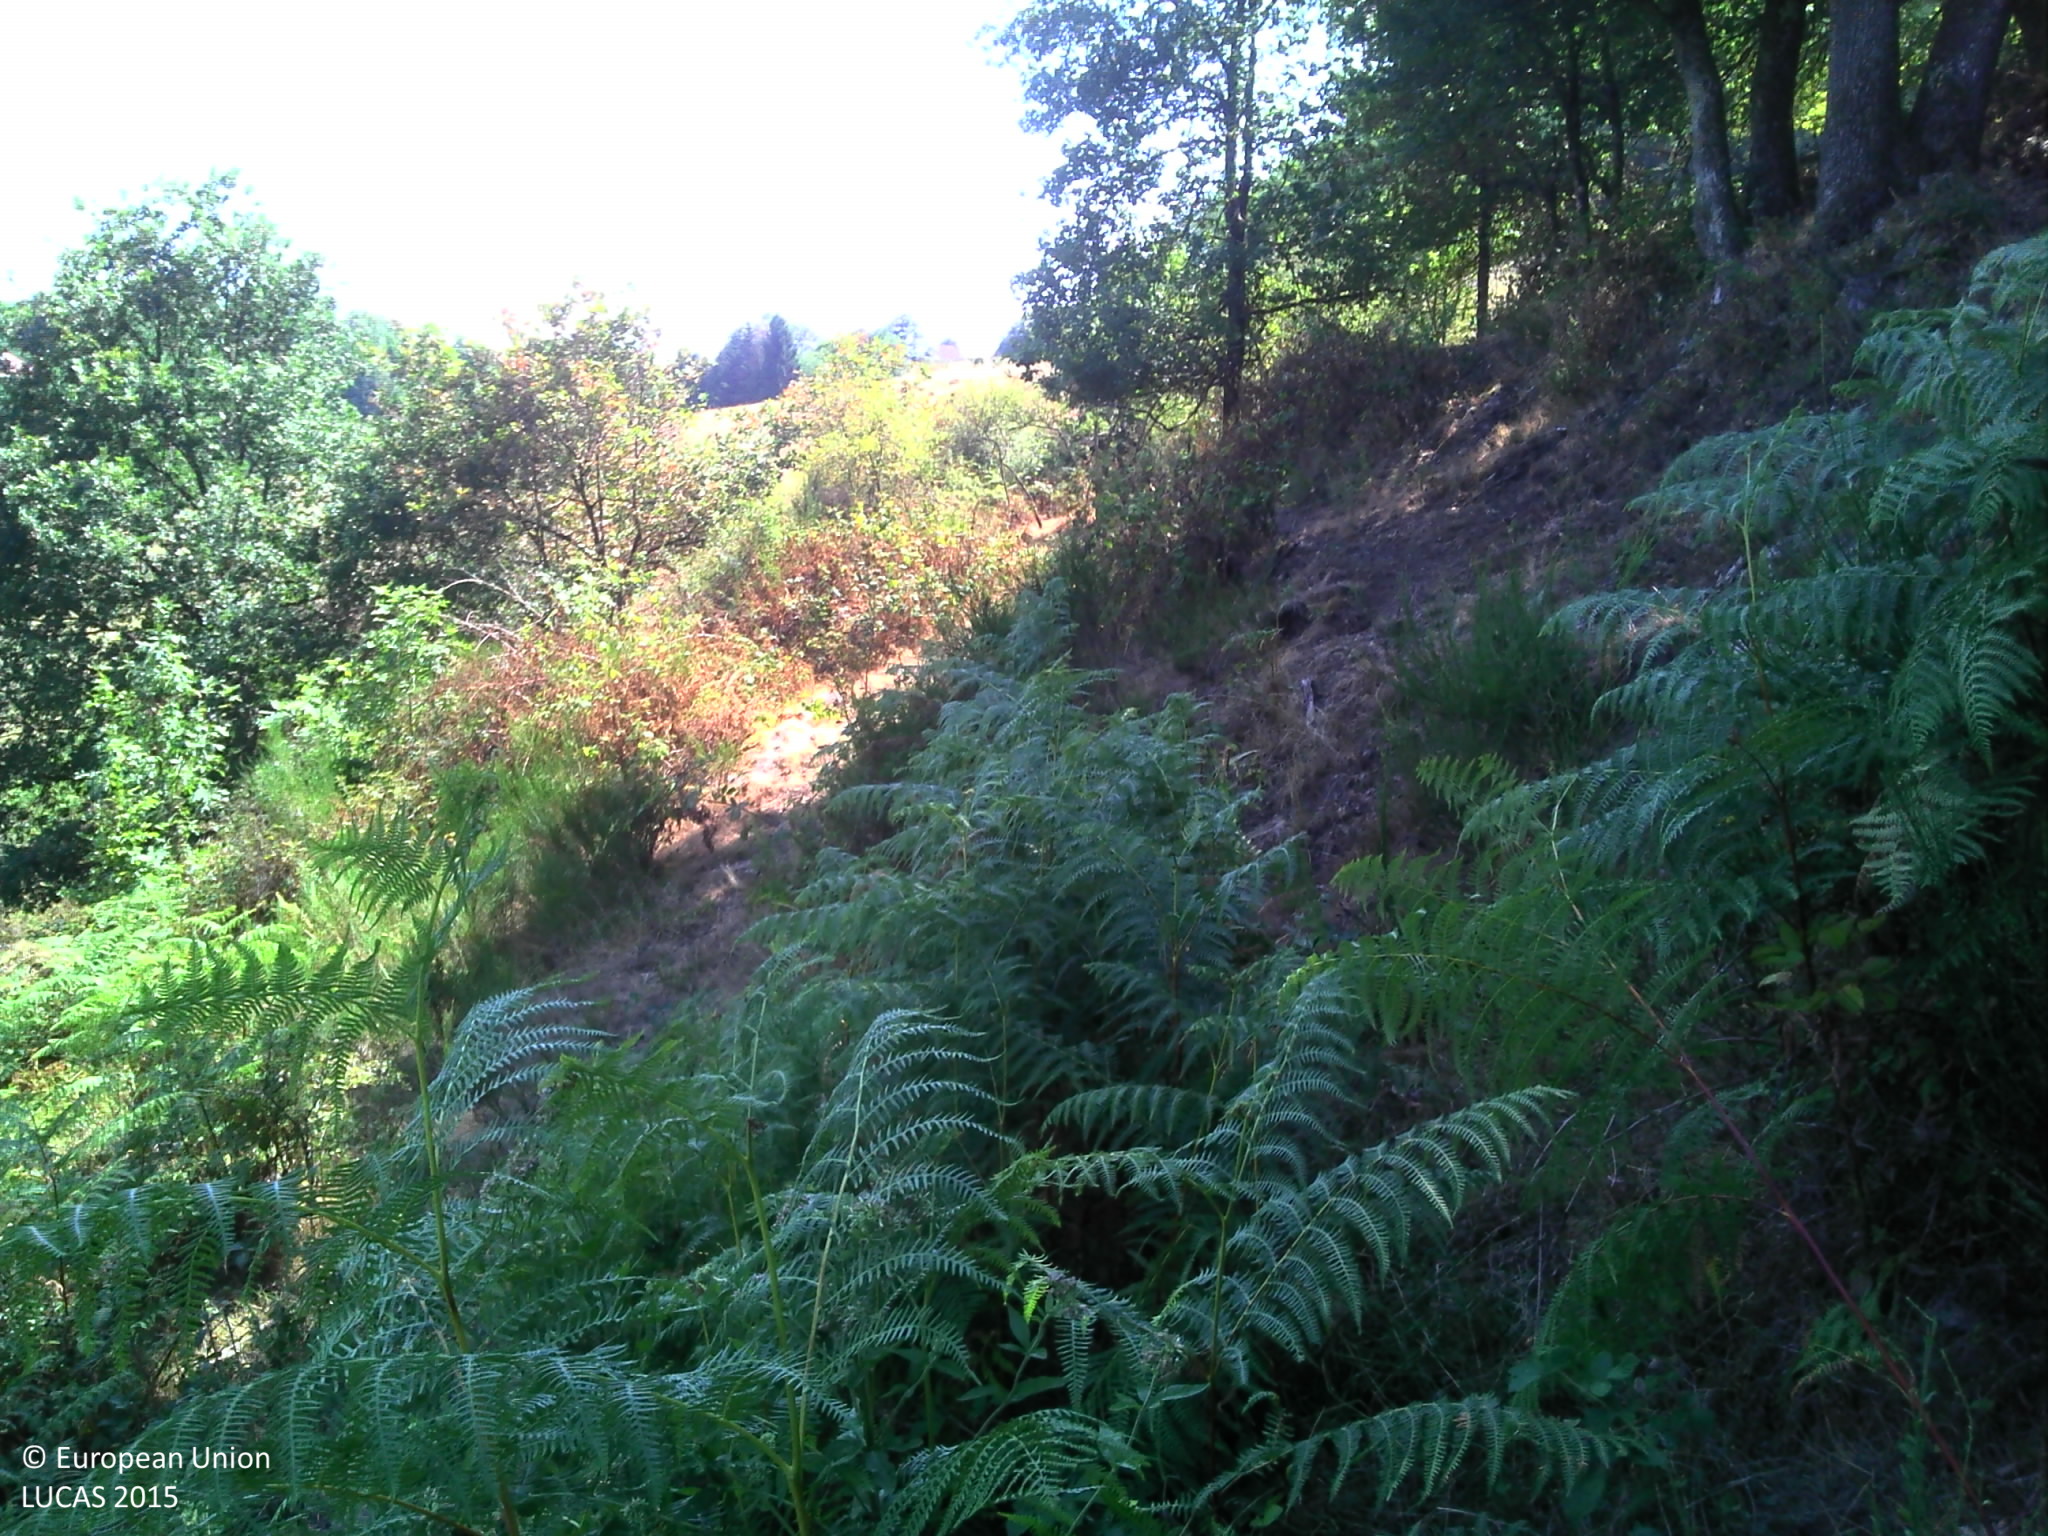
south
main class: Grassland
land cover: Spontaneously vegetated surfaces
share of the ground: > 75 %
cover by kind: herbaceous plants 95 %, shrubs 5 %
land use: Semi-natural and natural areas not in use
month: August
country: FR
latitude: 46.8198
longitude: 4.4299
